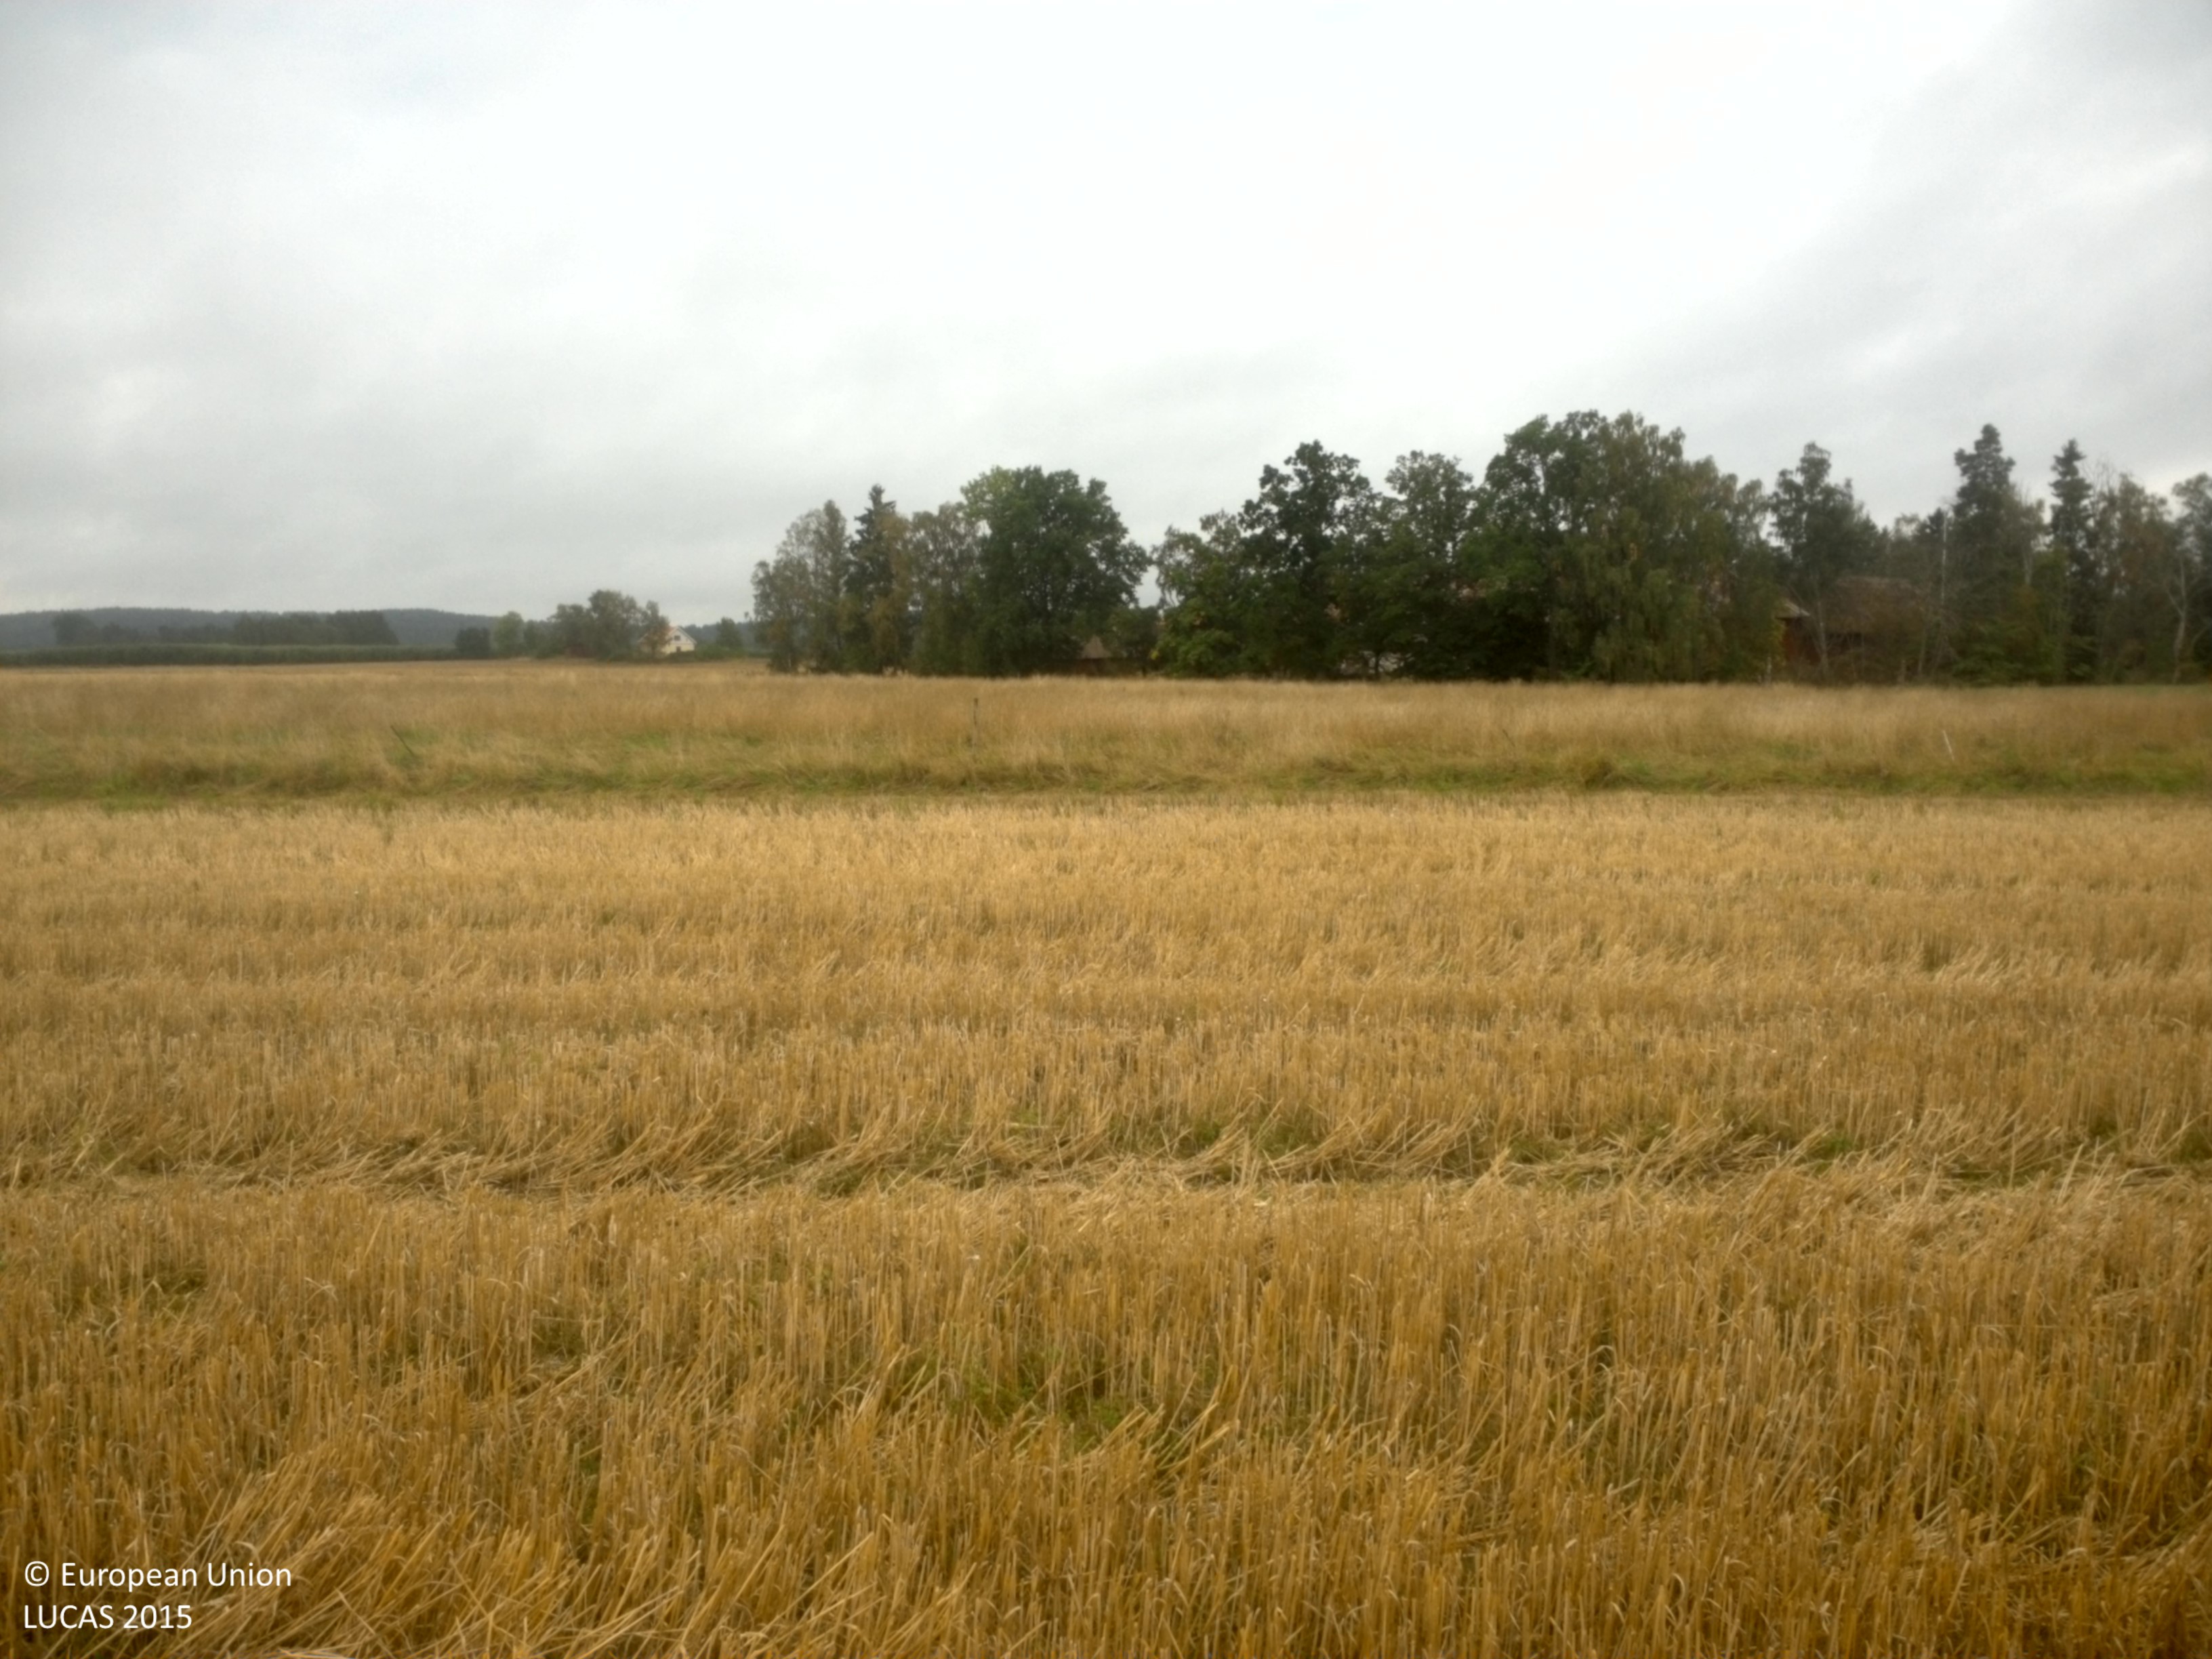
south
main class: Cropland
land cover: Common wheat
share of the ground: > 75 %
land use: Agriculture (excluding fallow land and kitchen gardens)
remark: Harvested field
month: September
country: SE
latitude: 59.4193
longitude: 15.6129
